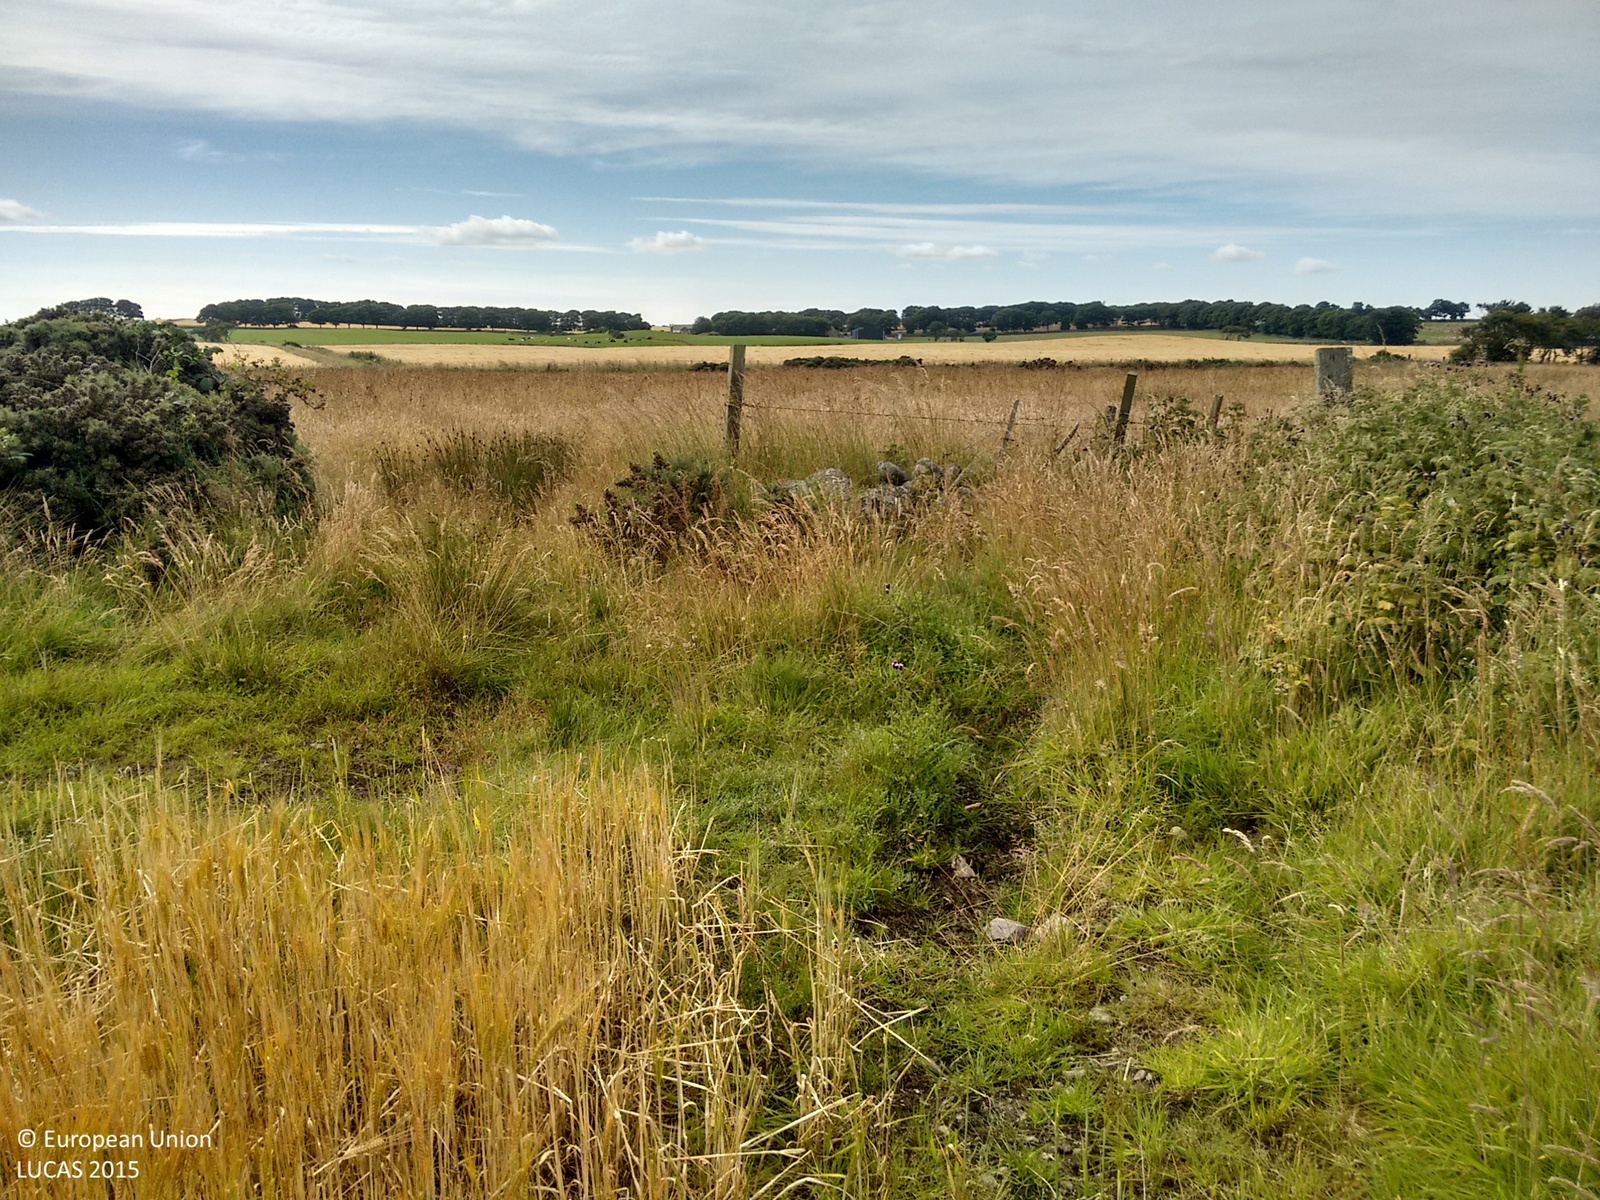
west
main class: Cropland
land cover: Barley
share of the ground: > 75 %
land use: Agriculture (excluding fallow land and kitchen gardens)
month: August
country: GB
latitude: 57.2163
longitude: -2.0860
